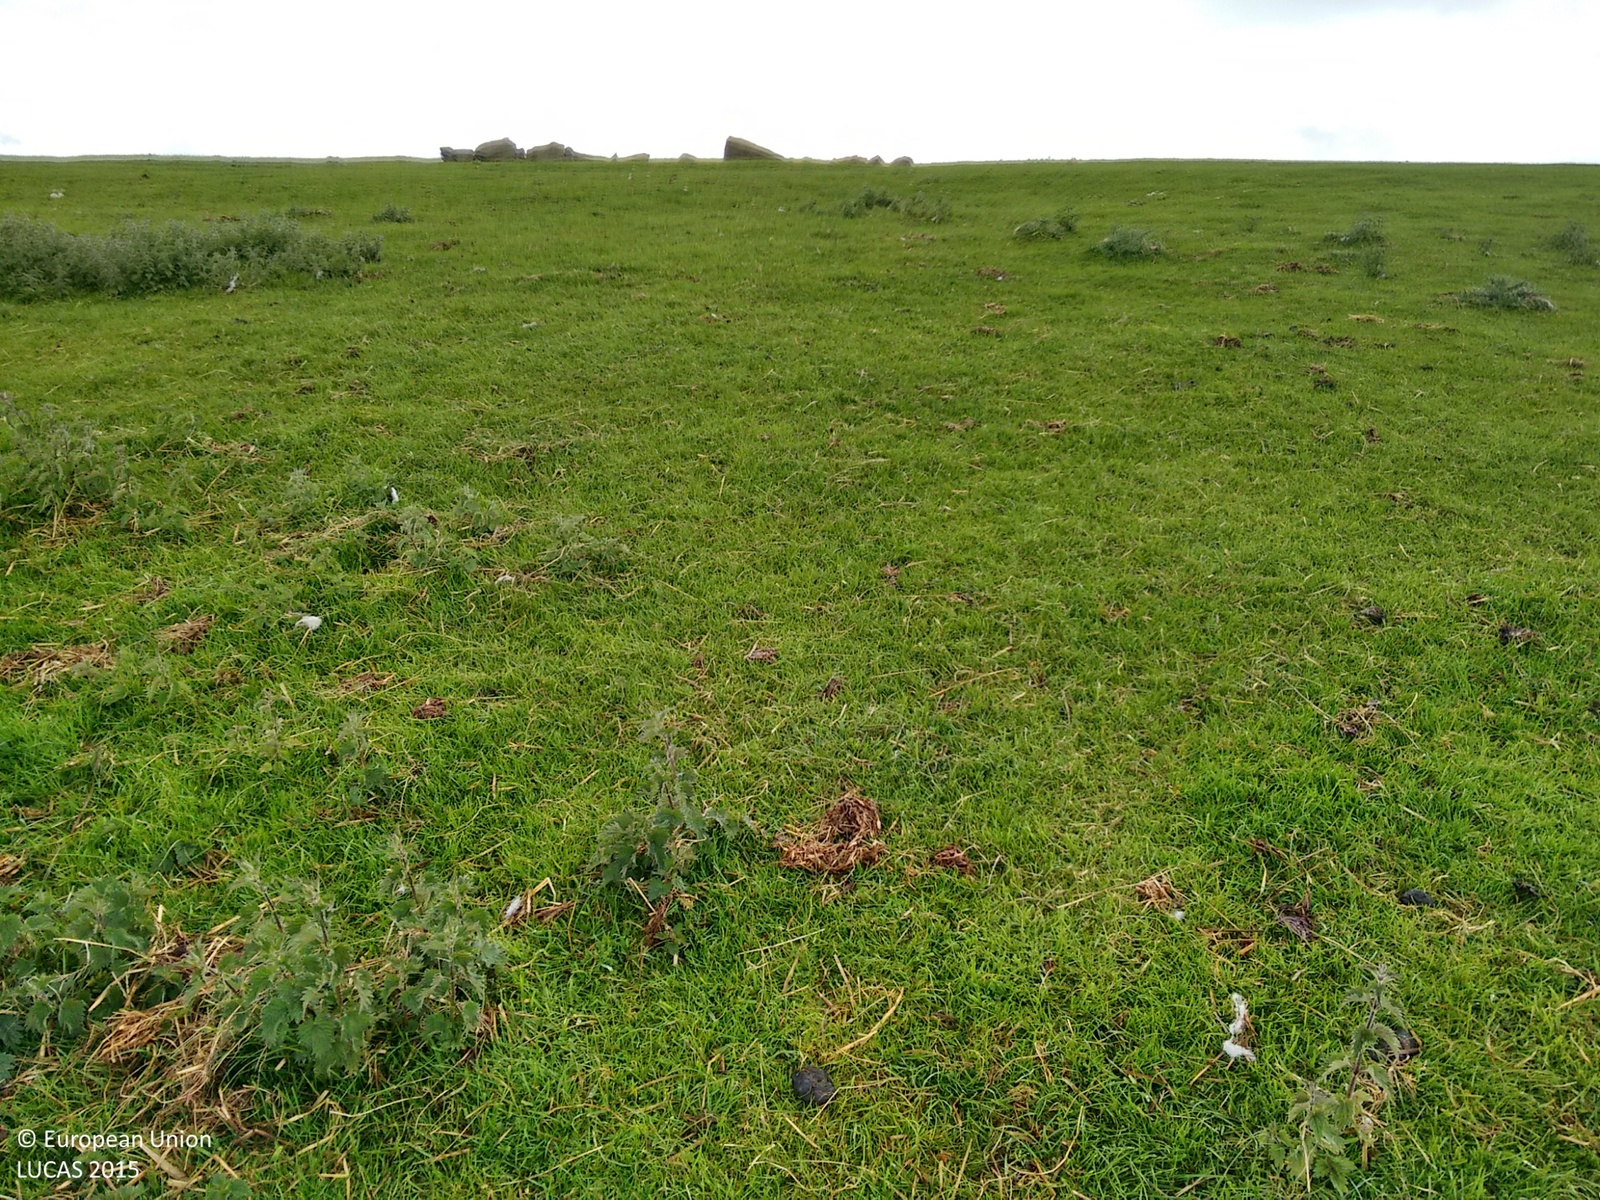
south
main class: Grassland
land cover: Grassland without tree/shrub cover
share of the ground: > 75 %
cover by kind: herbaceous plants 100 %
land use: Agriculture (excluding fallow land and kitchen gardens)
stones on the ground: < 10 %
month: May
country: GB
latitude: 53.9406
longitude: -1.7064
